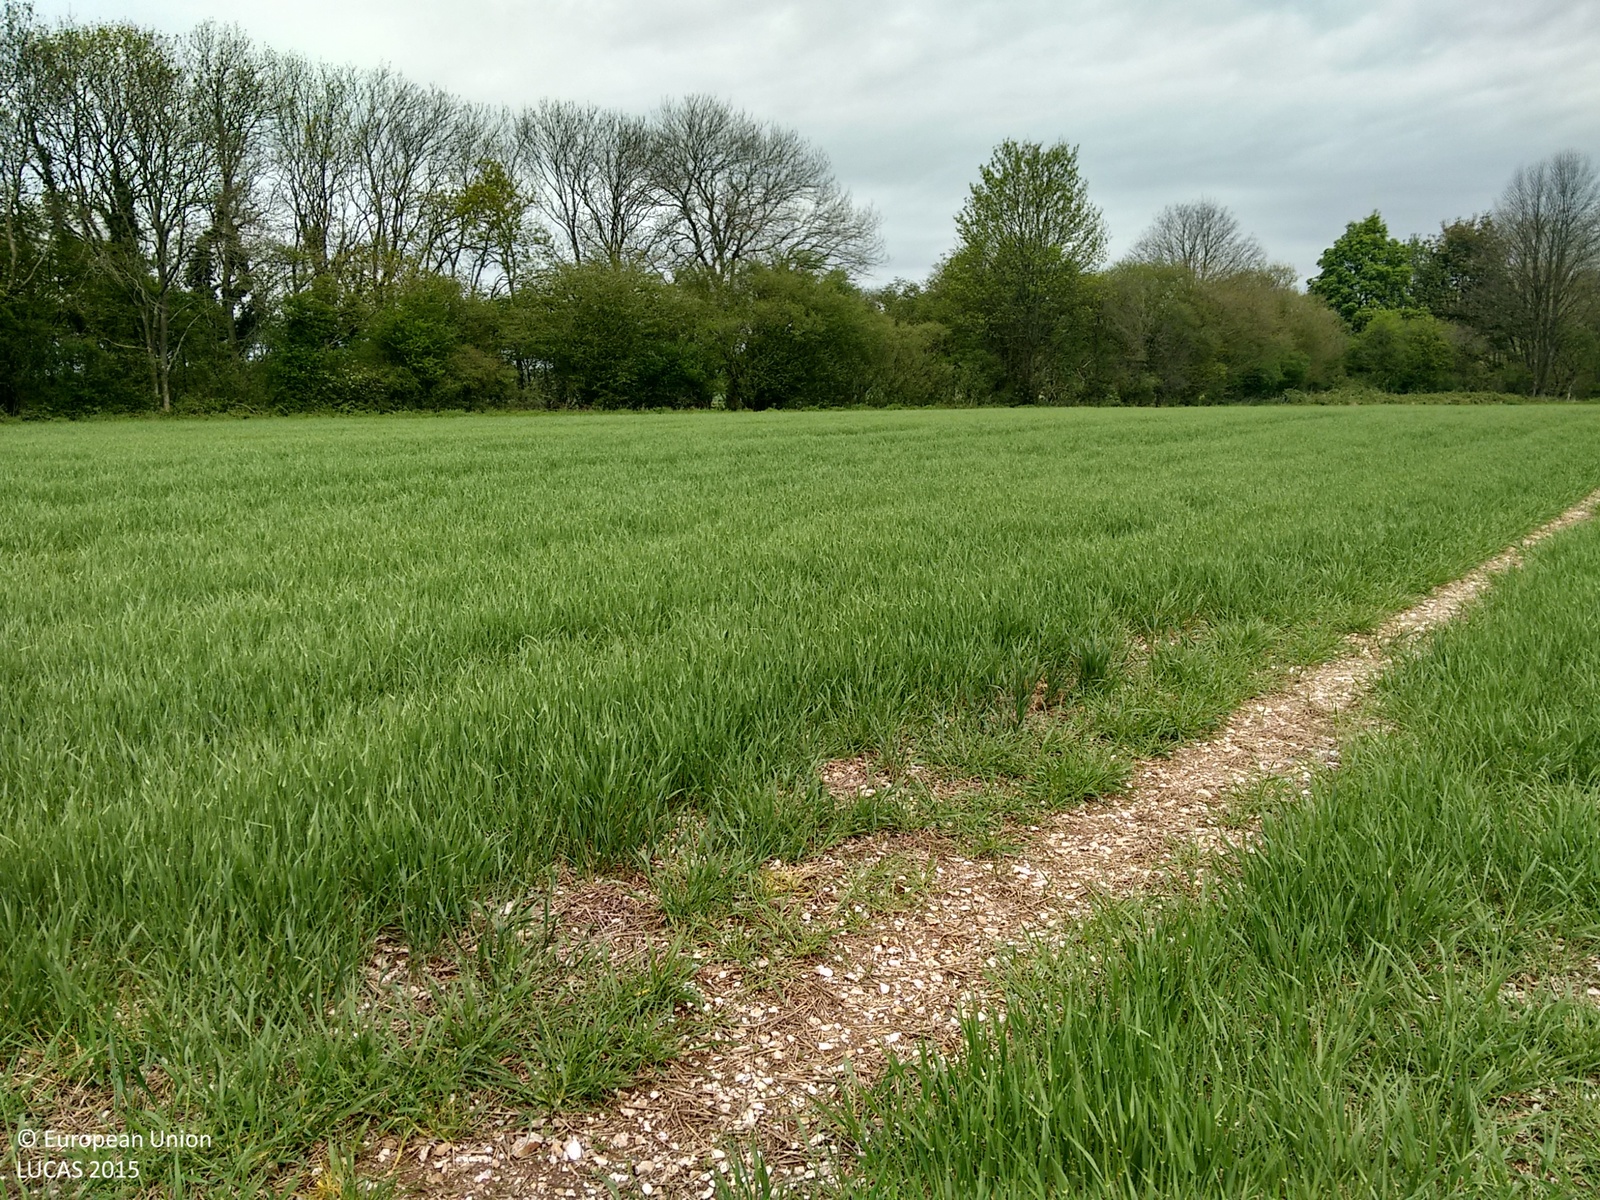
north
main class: Cropland
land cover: Barley
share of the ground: > 75 %
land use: Agriculture (excluding fallow land and kitchen gardens)
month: May
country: GB
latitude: 51.3299
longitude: -1.4604
